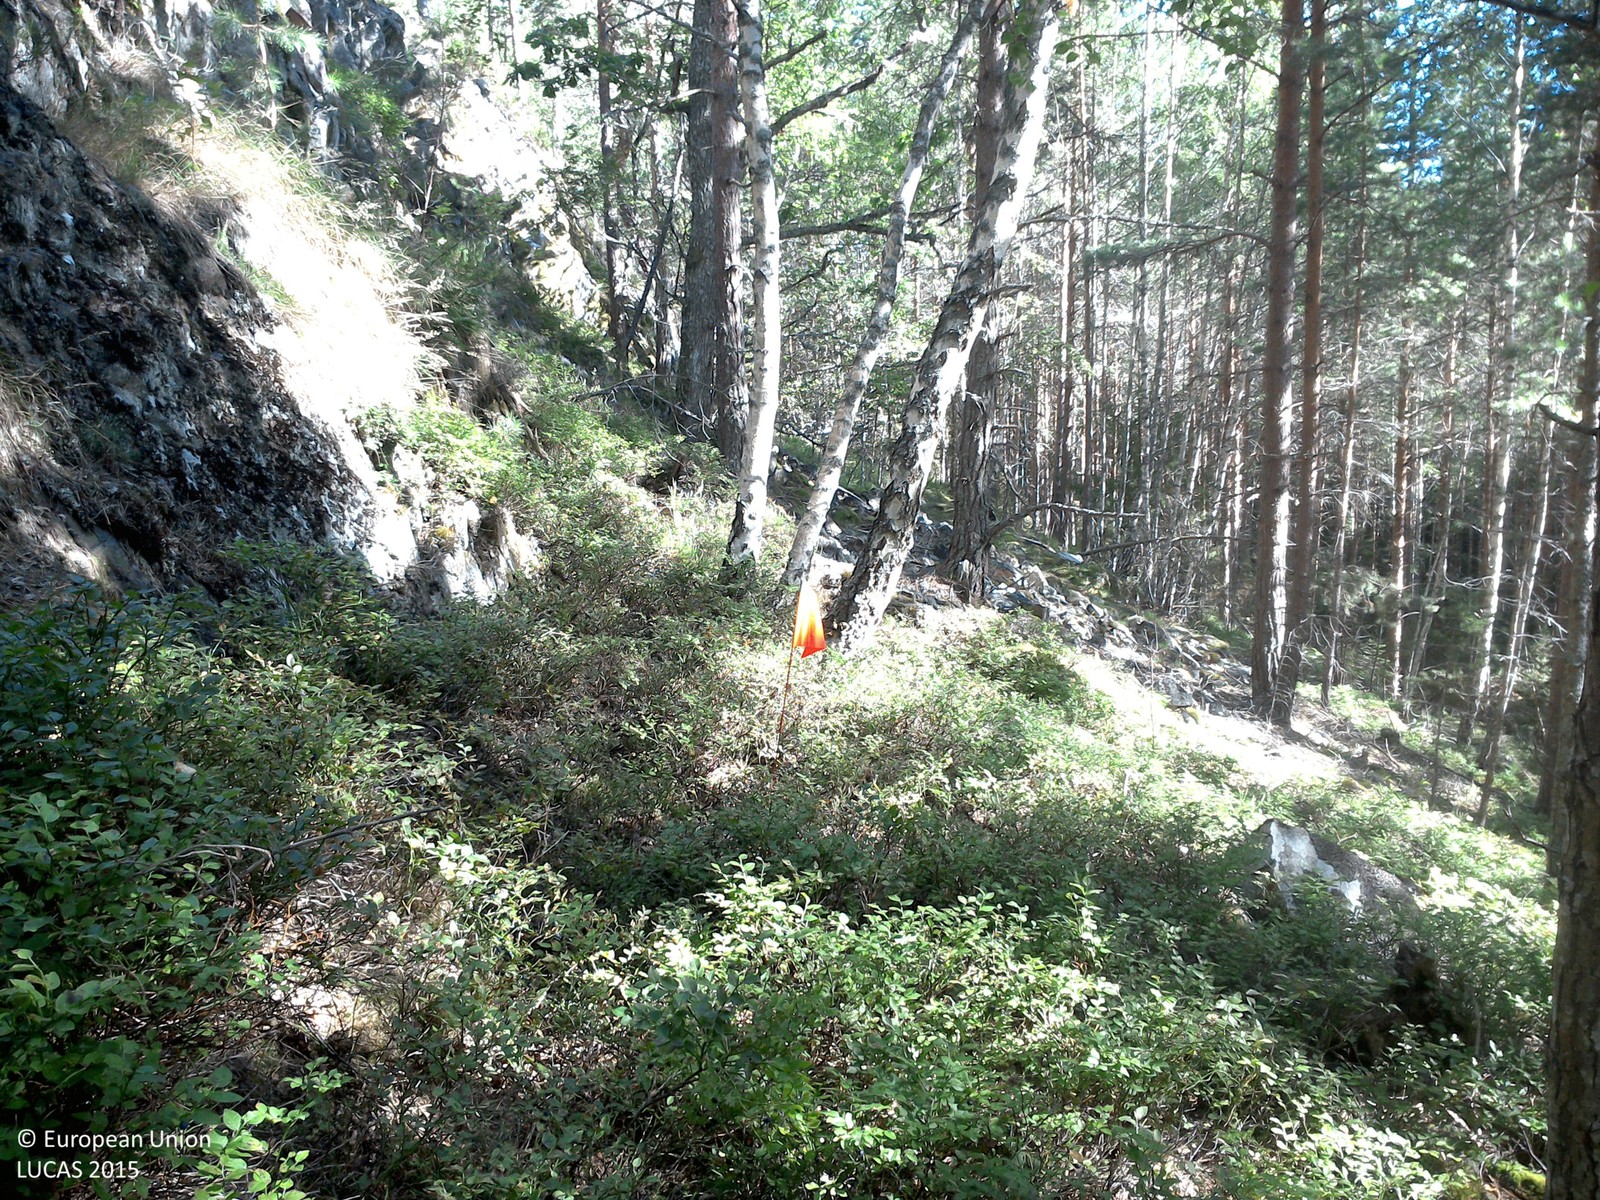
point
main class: Woodland
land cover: Pine dominated coniferous woodland
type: boreal forest
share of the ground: 50 - 75 %
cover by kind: coniferous forest trees 70 %, herbaceous plants 25 %, lichens and mosses 5 %
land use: Forestry
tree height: > 5 m
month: August
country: SE
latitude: 58.0224
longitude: 15.3620
